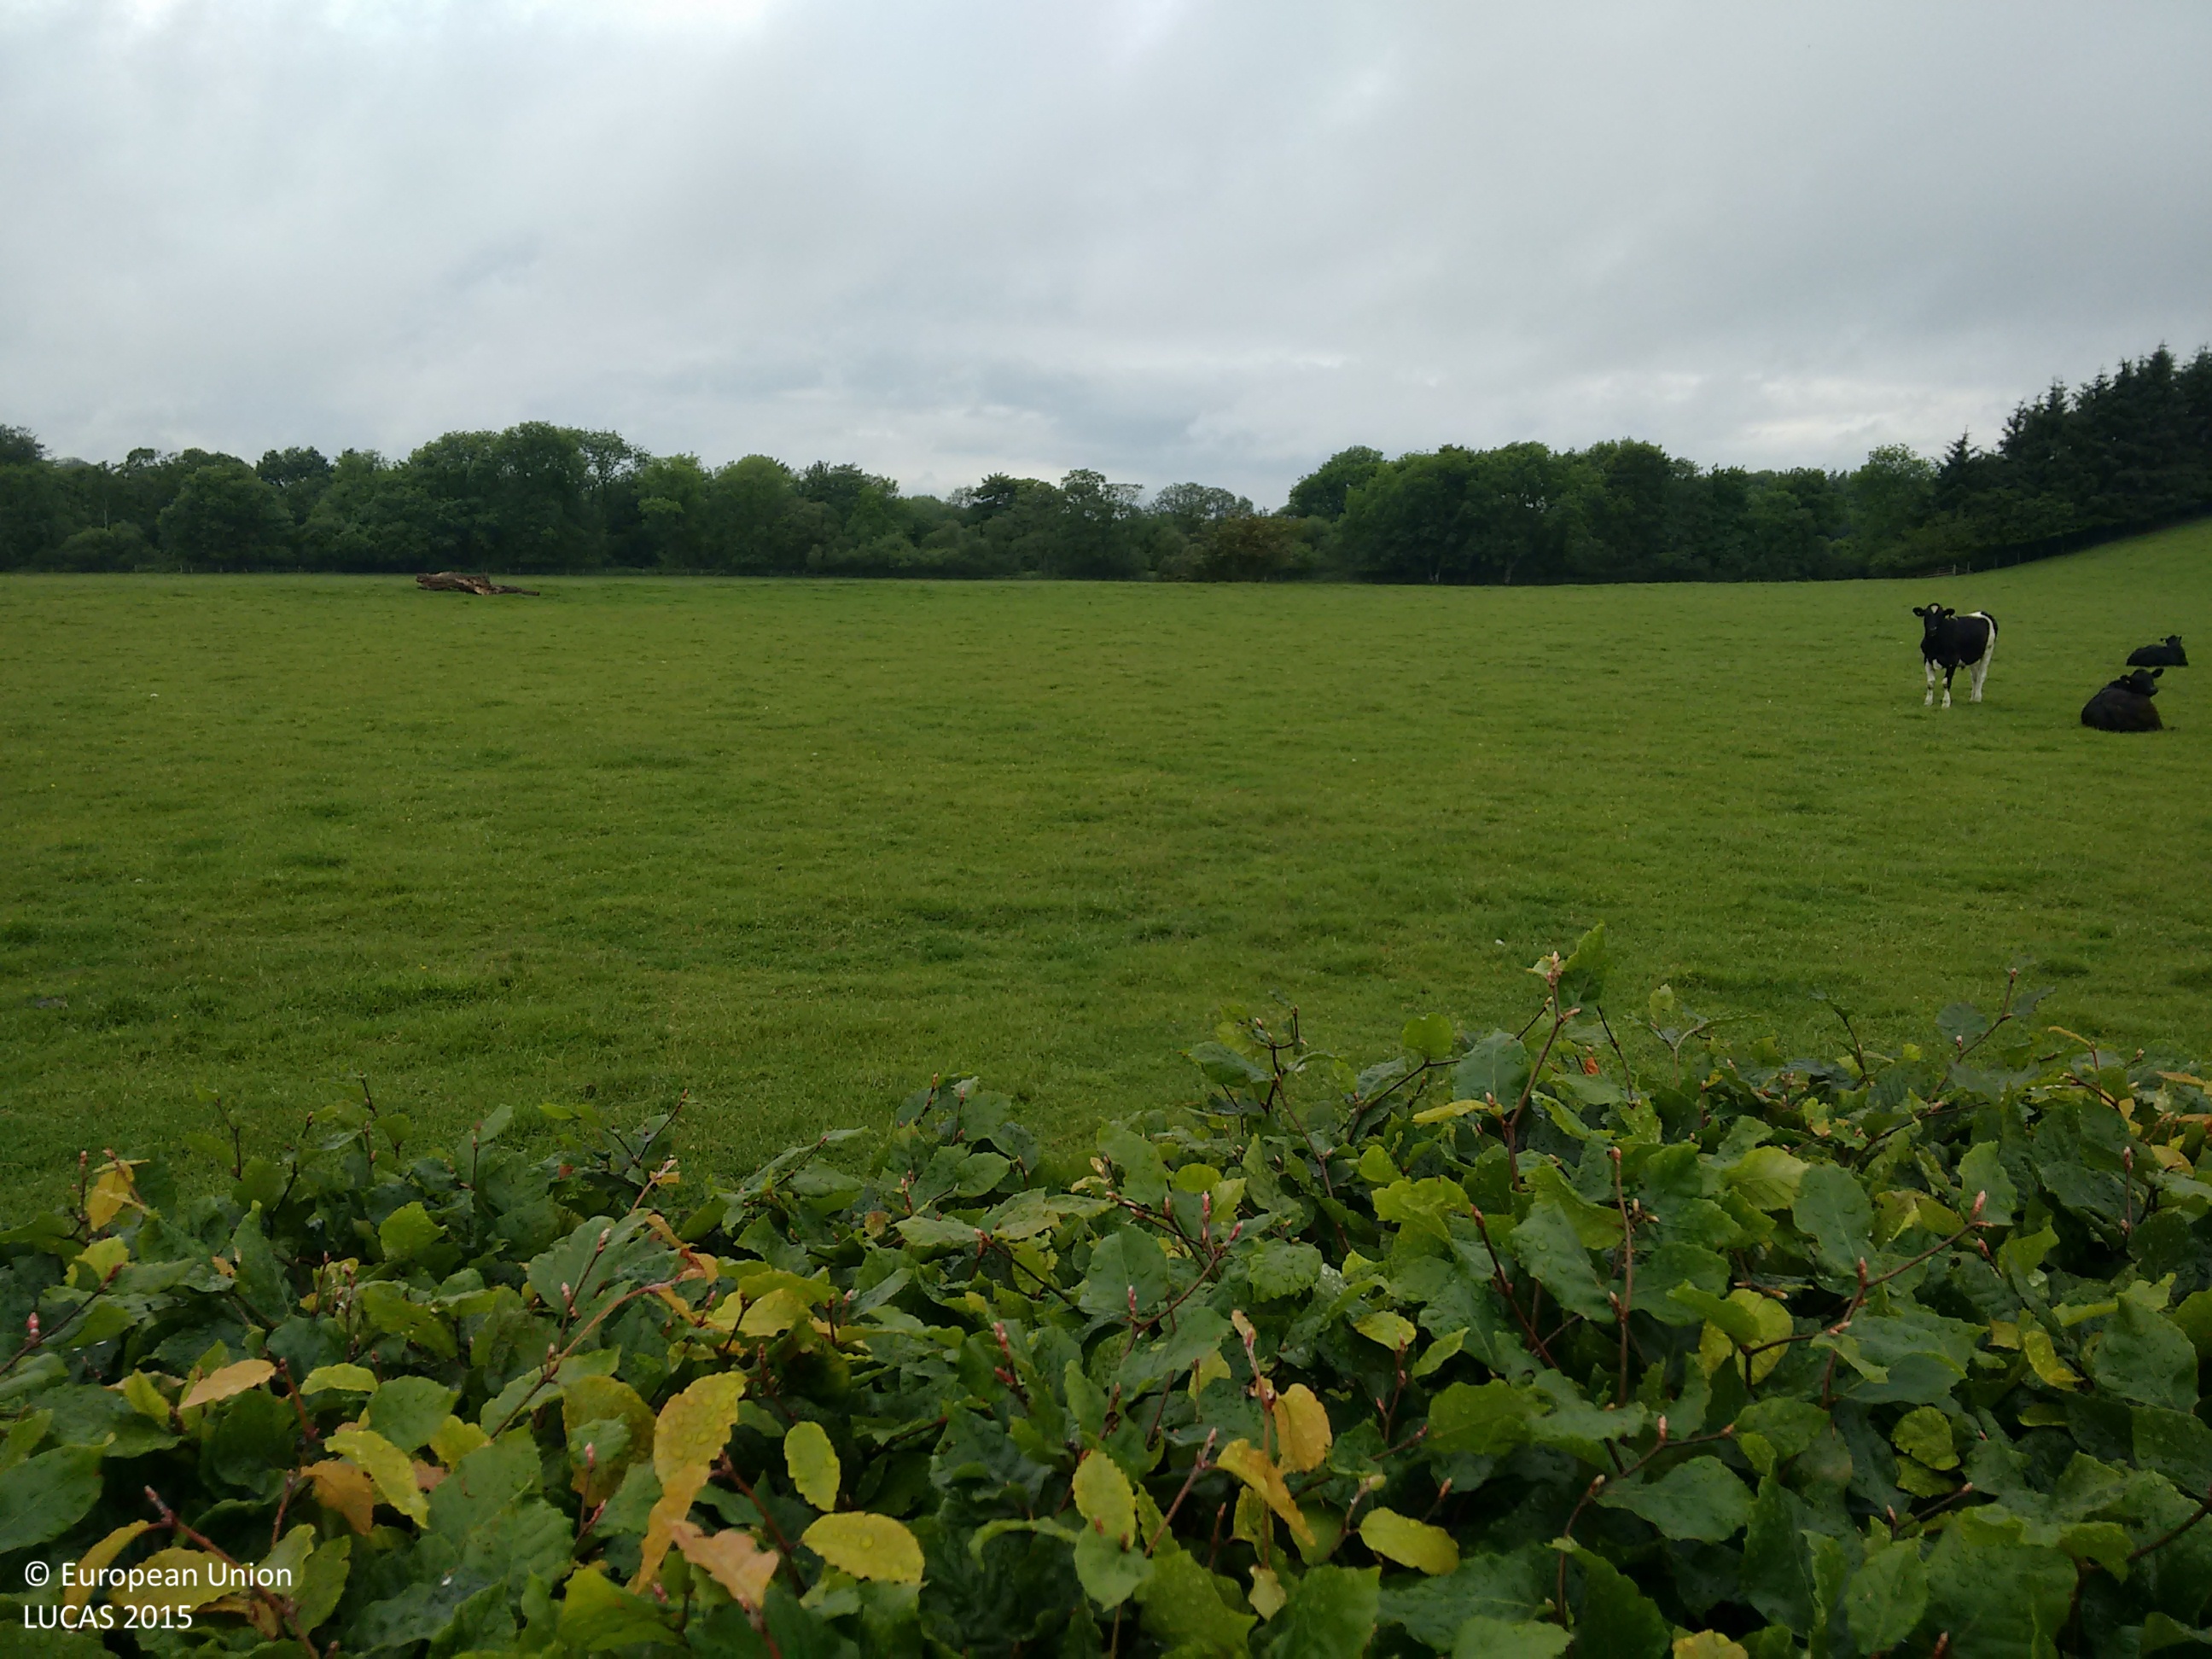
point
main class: Grassland
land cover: Grassland without tree/shrub cover
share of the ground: > 75 %
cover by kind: herbaceous plants 100 %
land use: Agriculture (excluding fallow land and kitchen gardens)
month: June
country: GB
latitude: 55.0496
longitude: -3.3348
